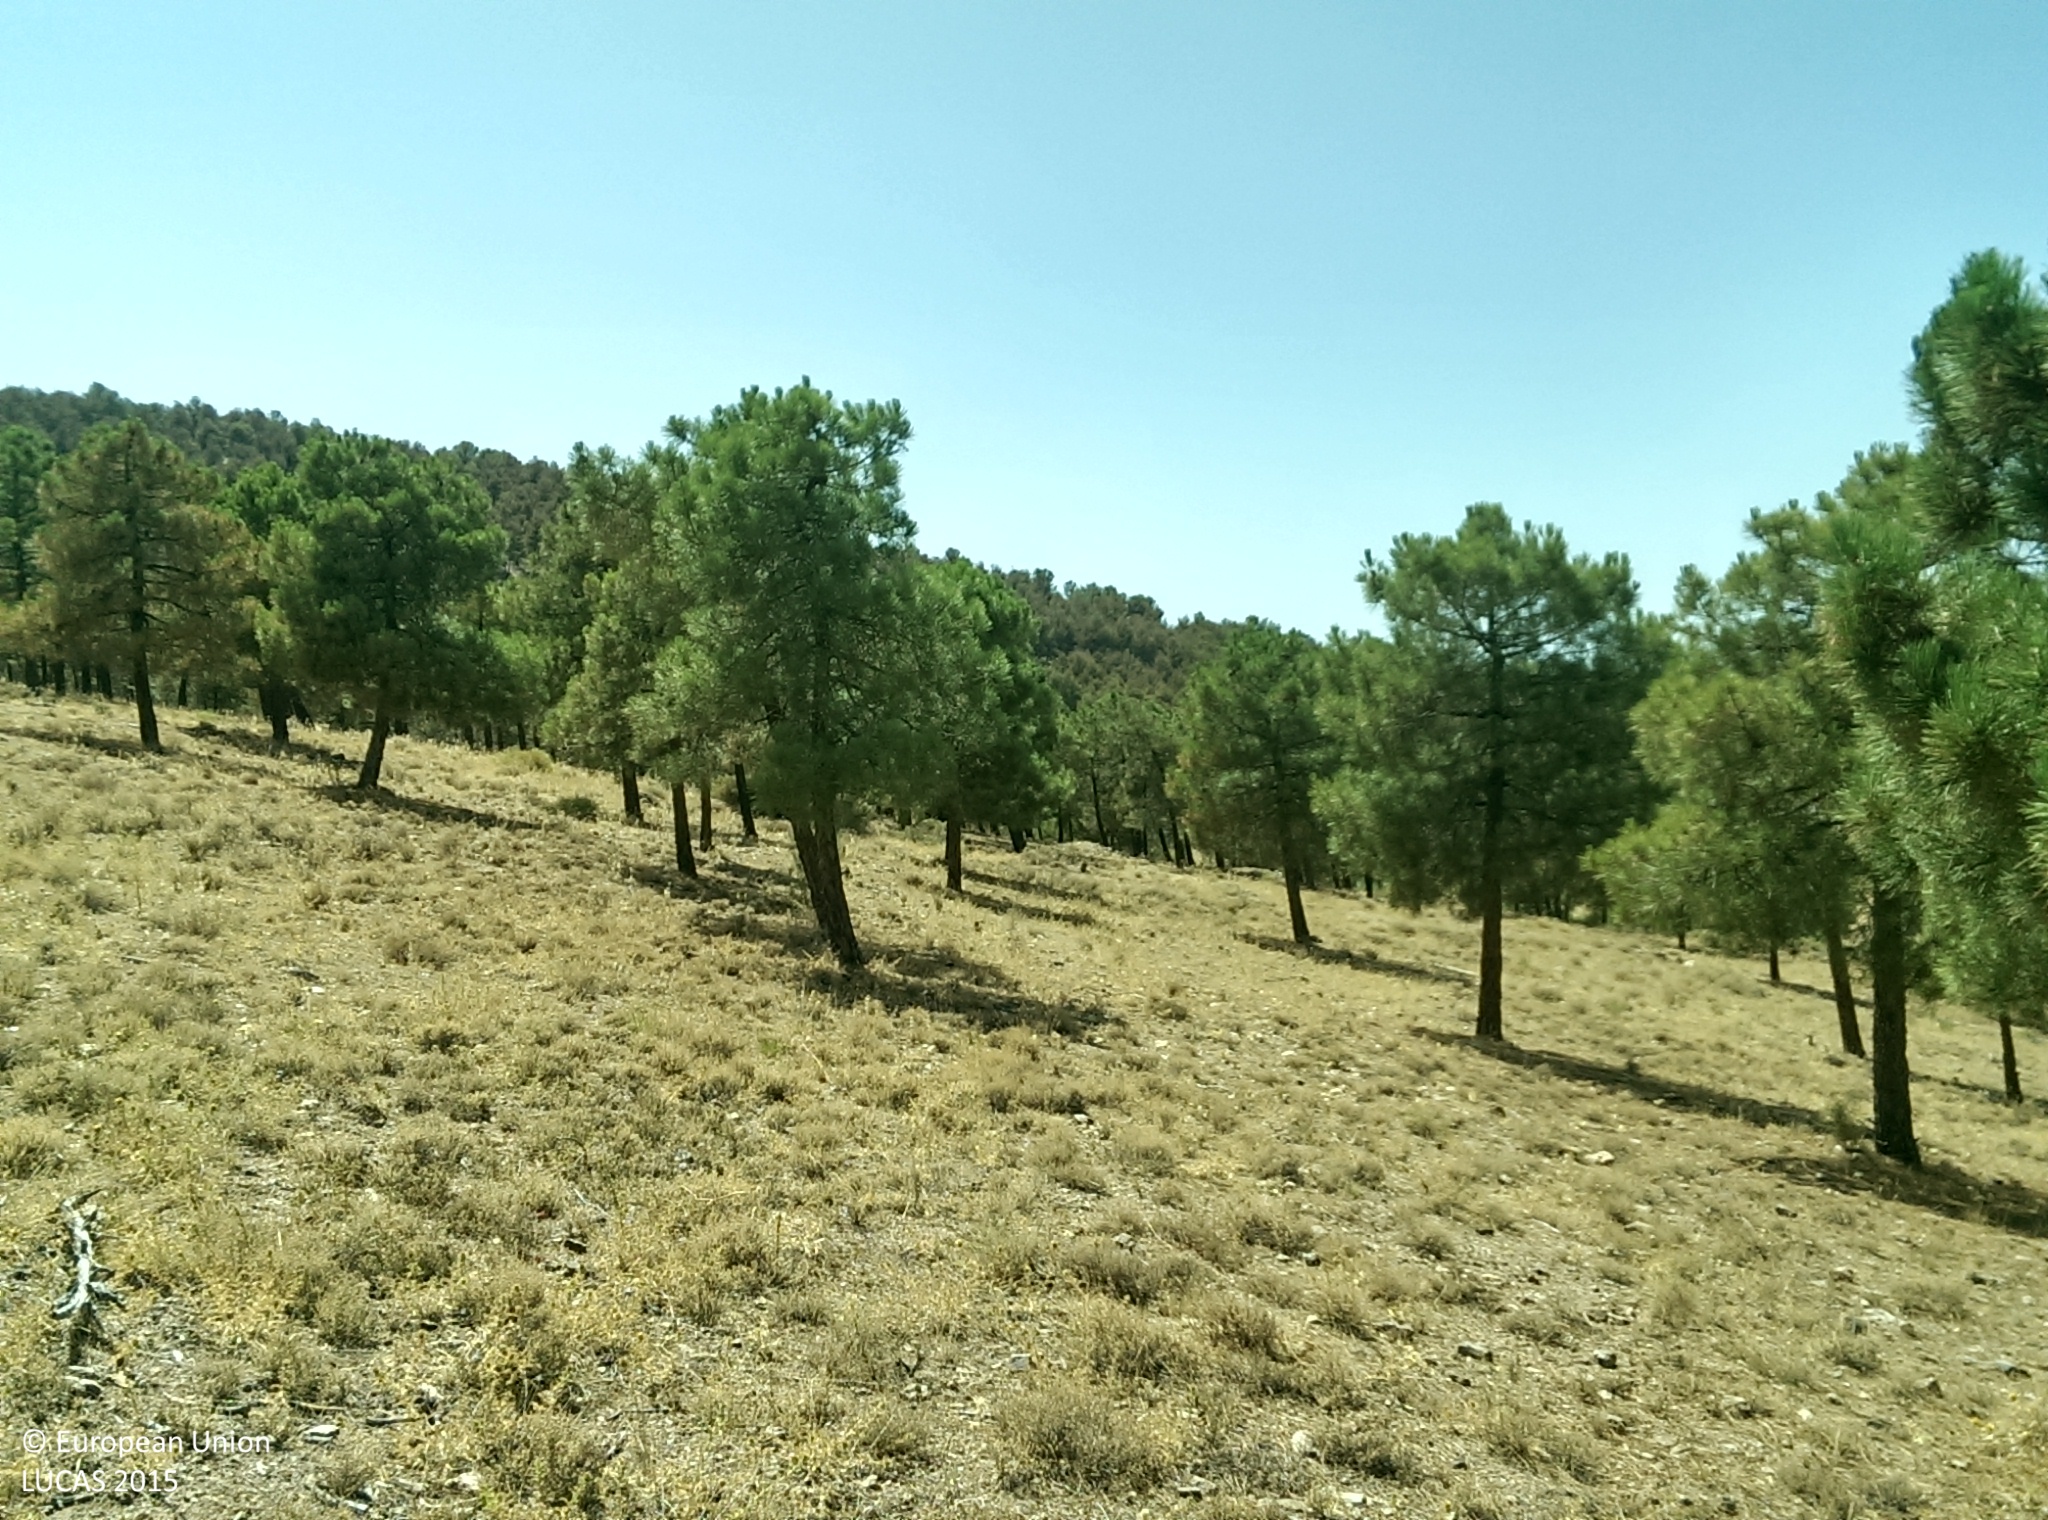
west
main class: Woodland
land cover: Pine dominated coniferous woodland
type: coniferous forest of the mediterranean region
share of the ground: 10 - 25 %
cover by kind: herbaceous plants 40 %, coniferous forest trees 20 %, shrubs 20 %, unconsolidated bare surface 20 %
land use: Forestry
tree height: > 5 m
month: July
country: ES
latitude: 37.2289
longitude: -3.1846
